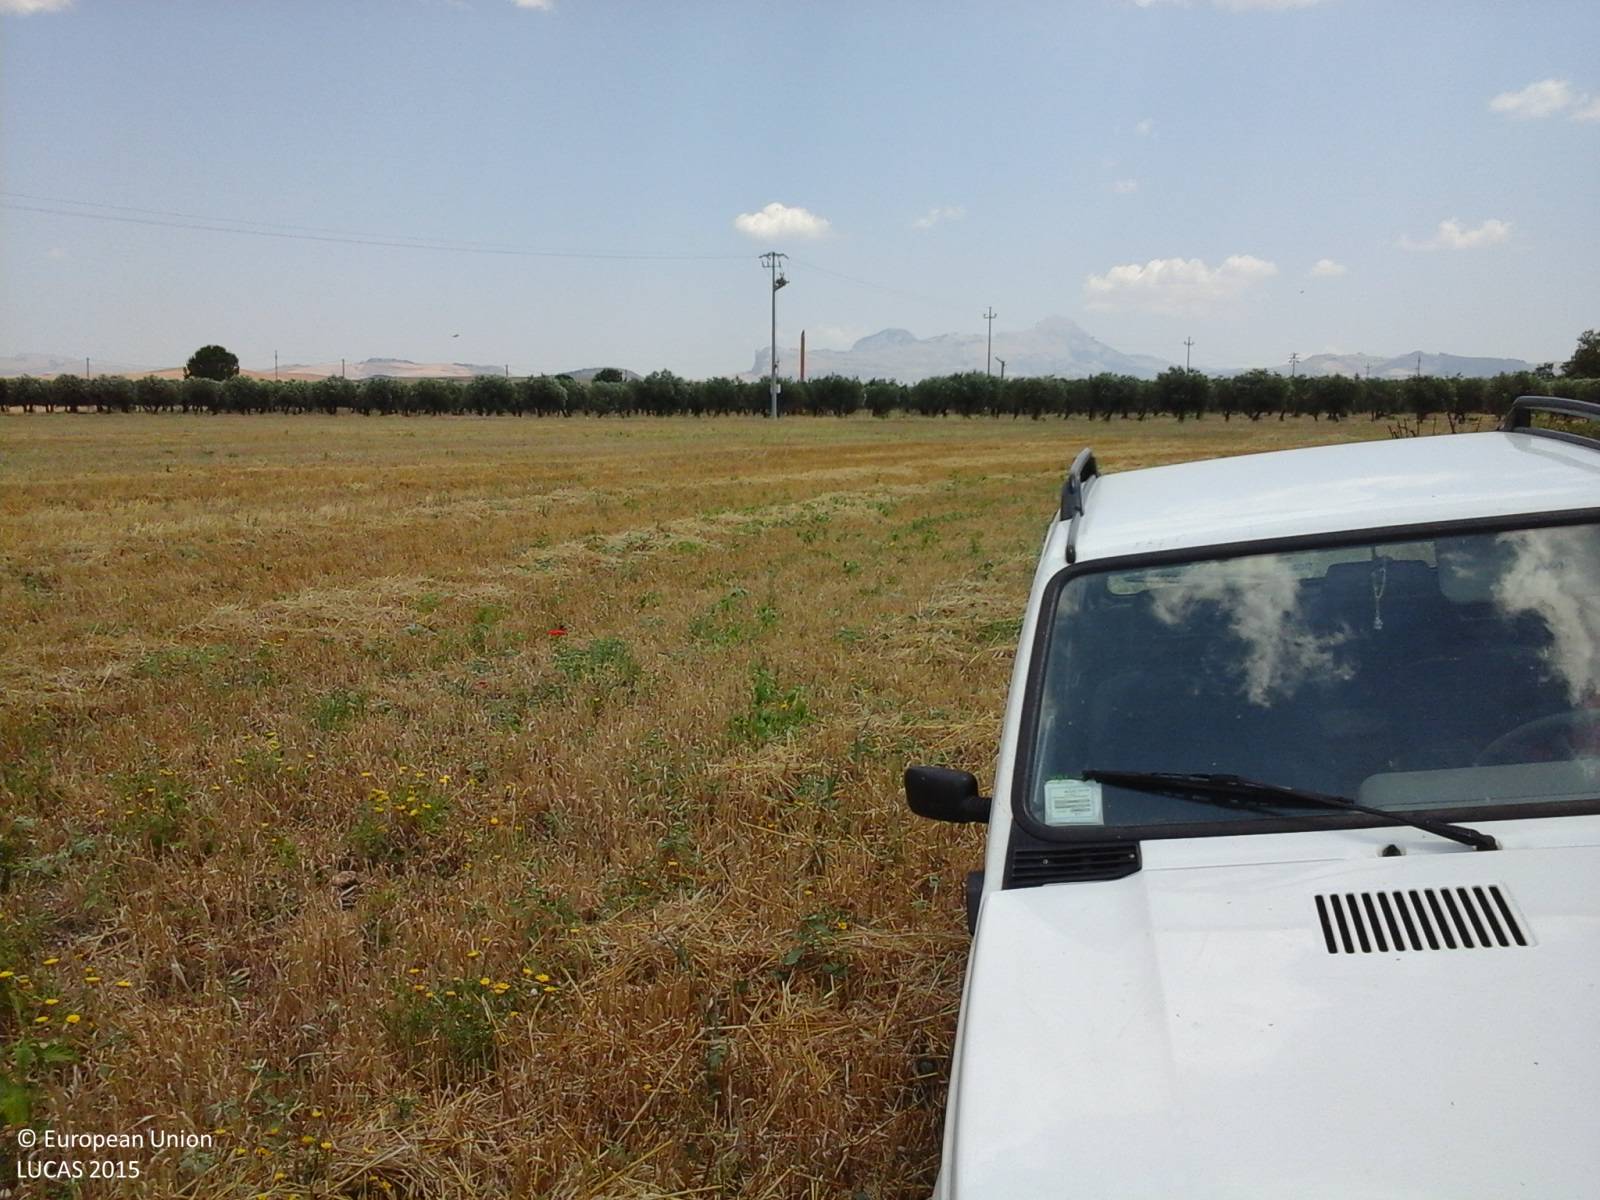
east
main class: Cropland
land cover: Barley
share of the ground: > 75 %
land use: Agriculture (excluding fallow land and kitchen gardens)
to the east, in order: Barley; Olive groves
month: July
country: IT
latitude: 37.8212
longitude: 13.1916
